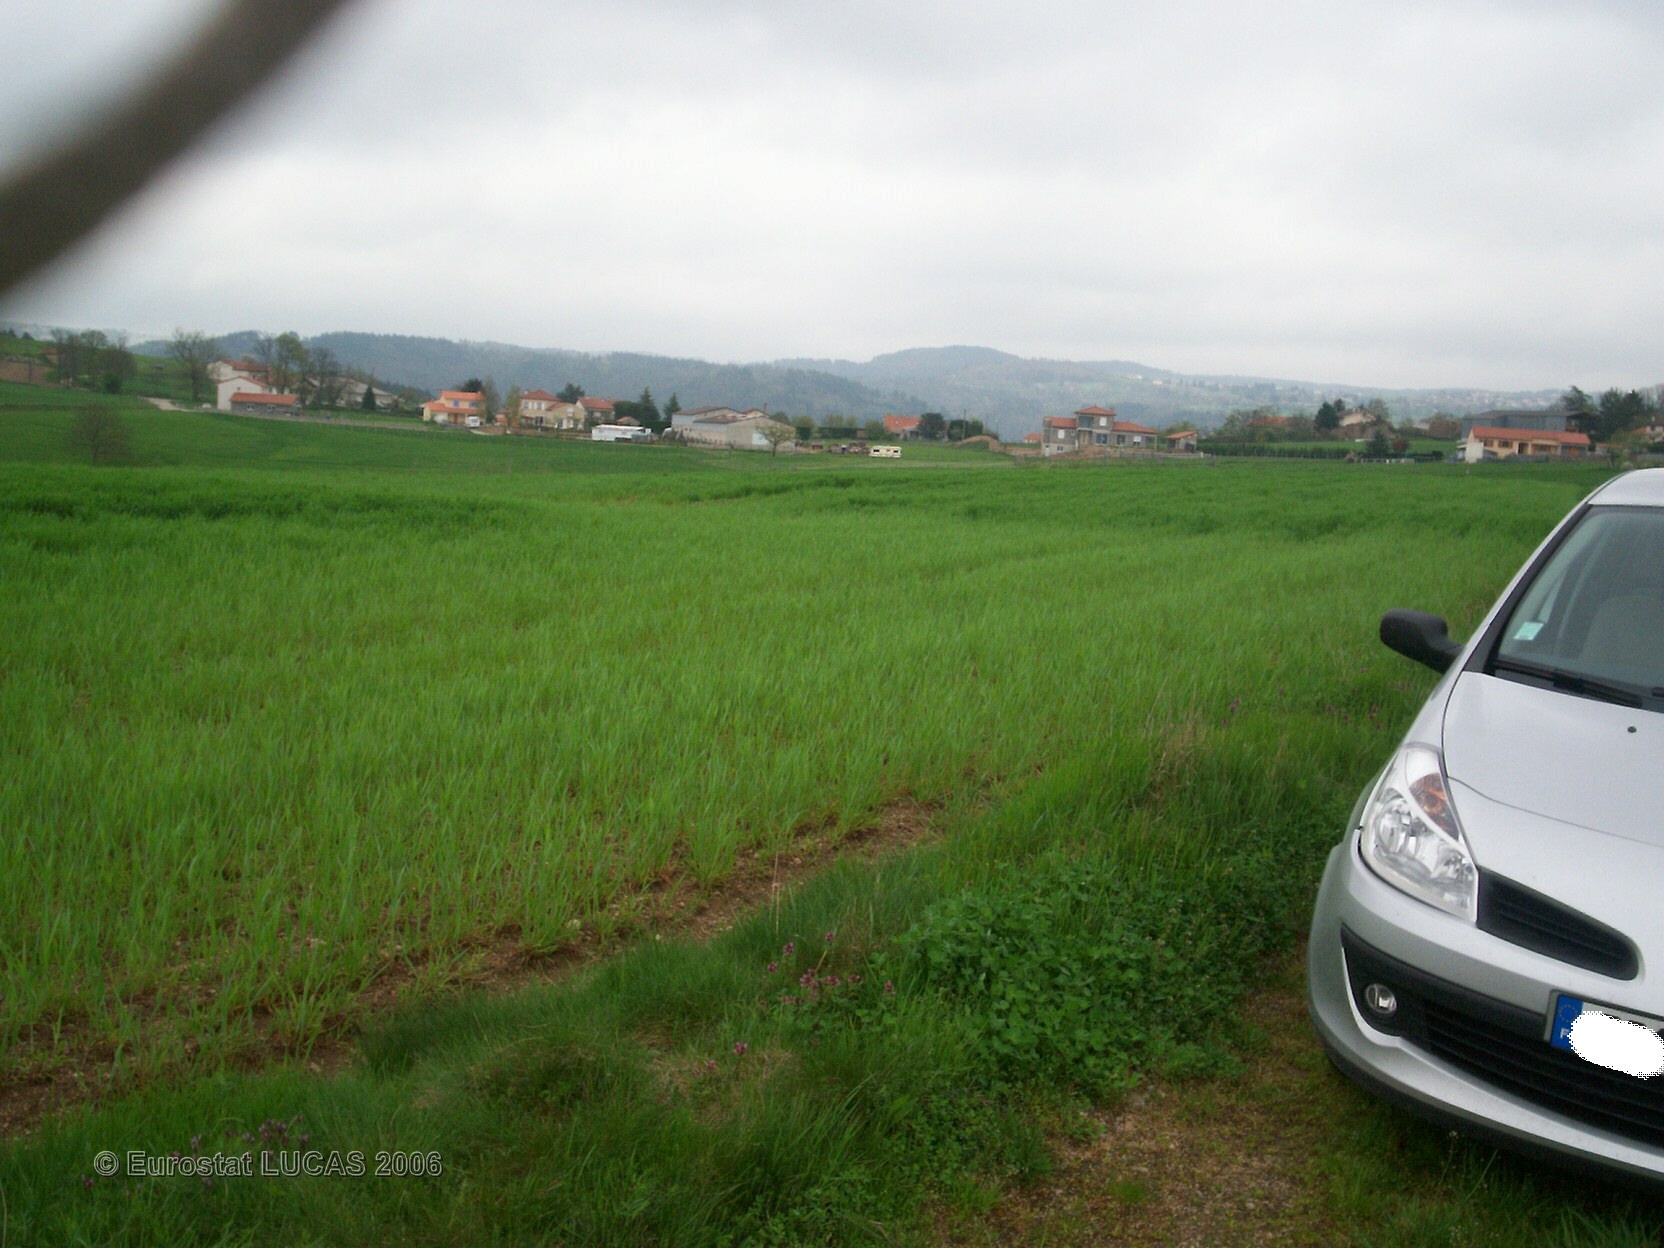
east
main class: Cropland
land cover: Rye
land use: Agriculture (excluding fallow land and kitchen gardens)
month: April
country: FR
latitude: 45.3434
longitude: 4.1714
